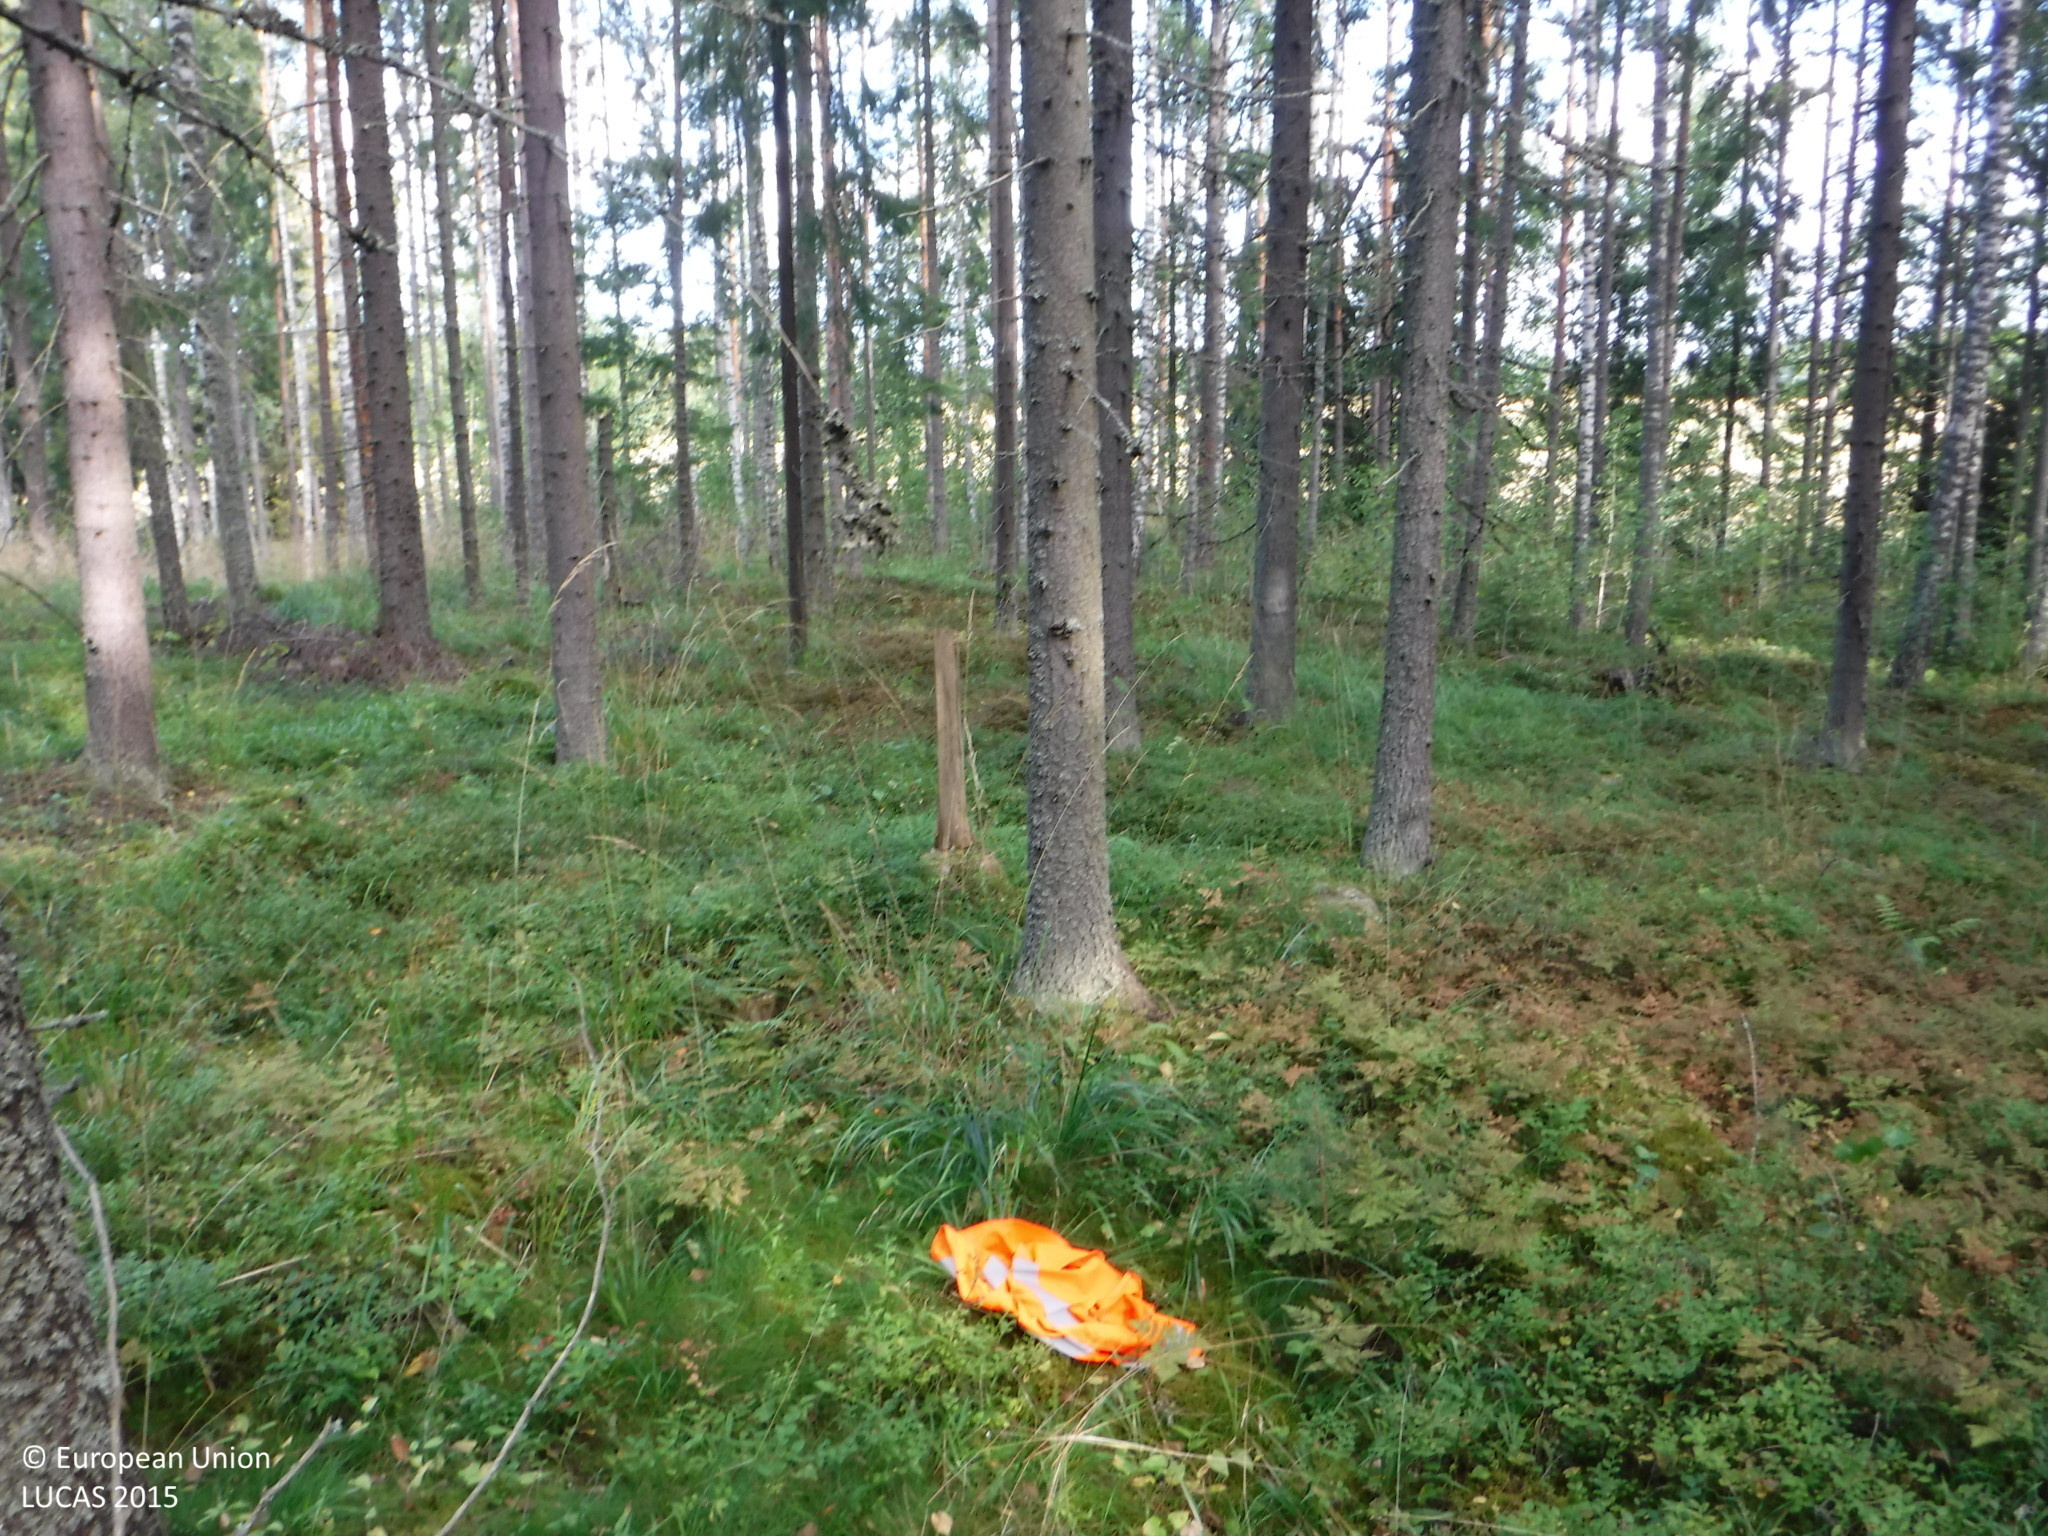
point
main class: Woodland
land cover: Spruce dominated coniferous woodland
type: boreal forest
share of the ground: 50 - 75 %
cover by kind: coniferous forest trees 70 %, shrubs 15 %, herbaceous plants 10 %, lichens and mosses 5 %
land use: Forestry
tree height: > 5 m
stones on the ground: < 10 %
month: August
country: FI
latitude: 61.3064
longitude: 22.0263
